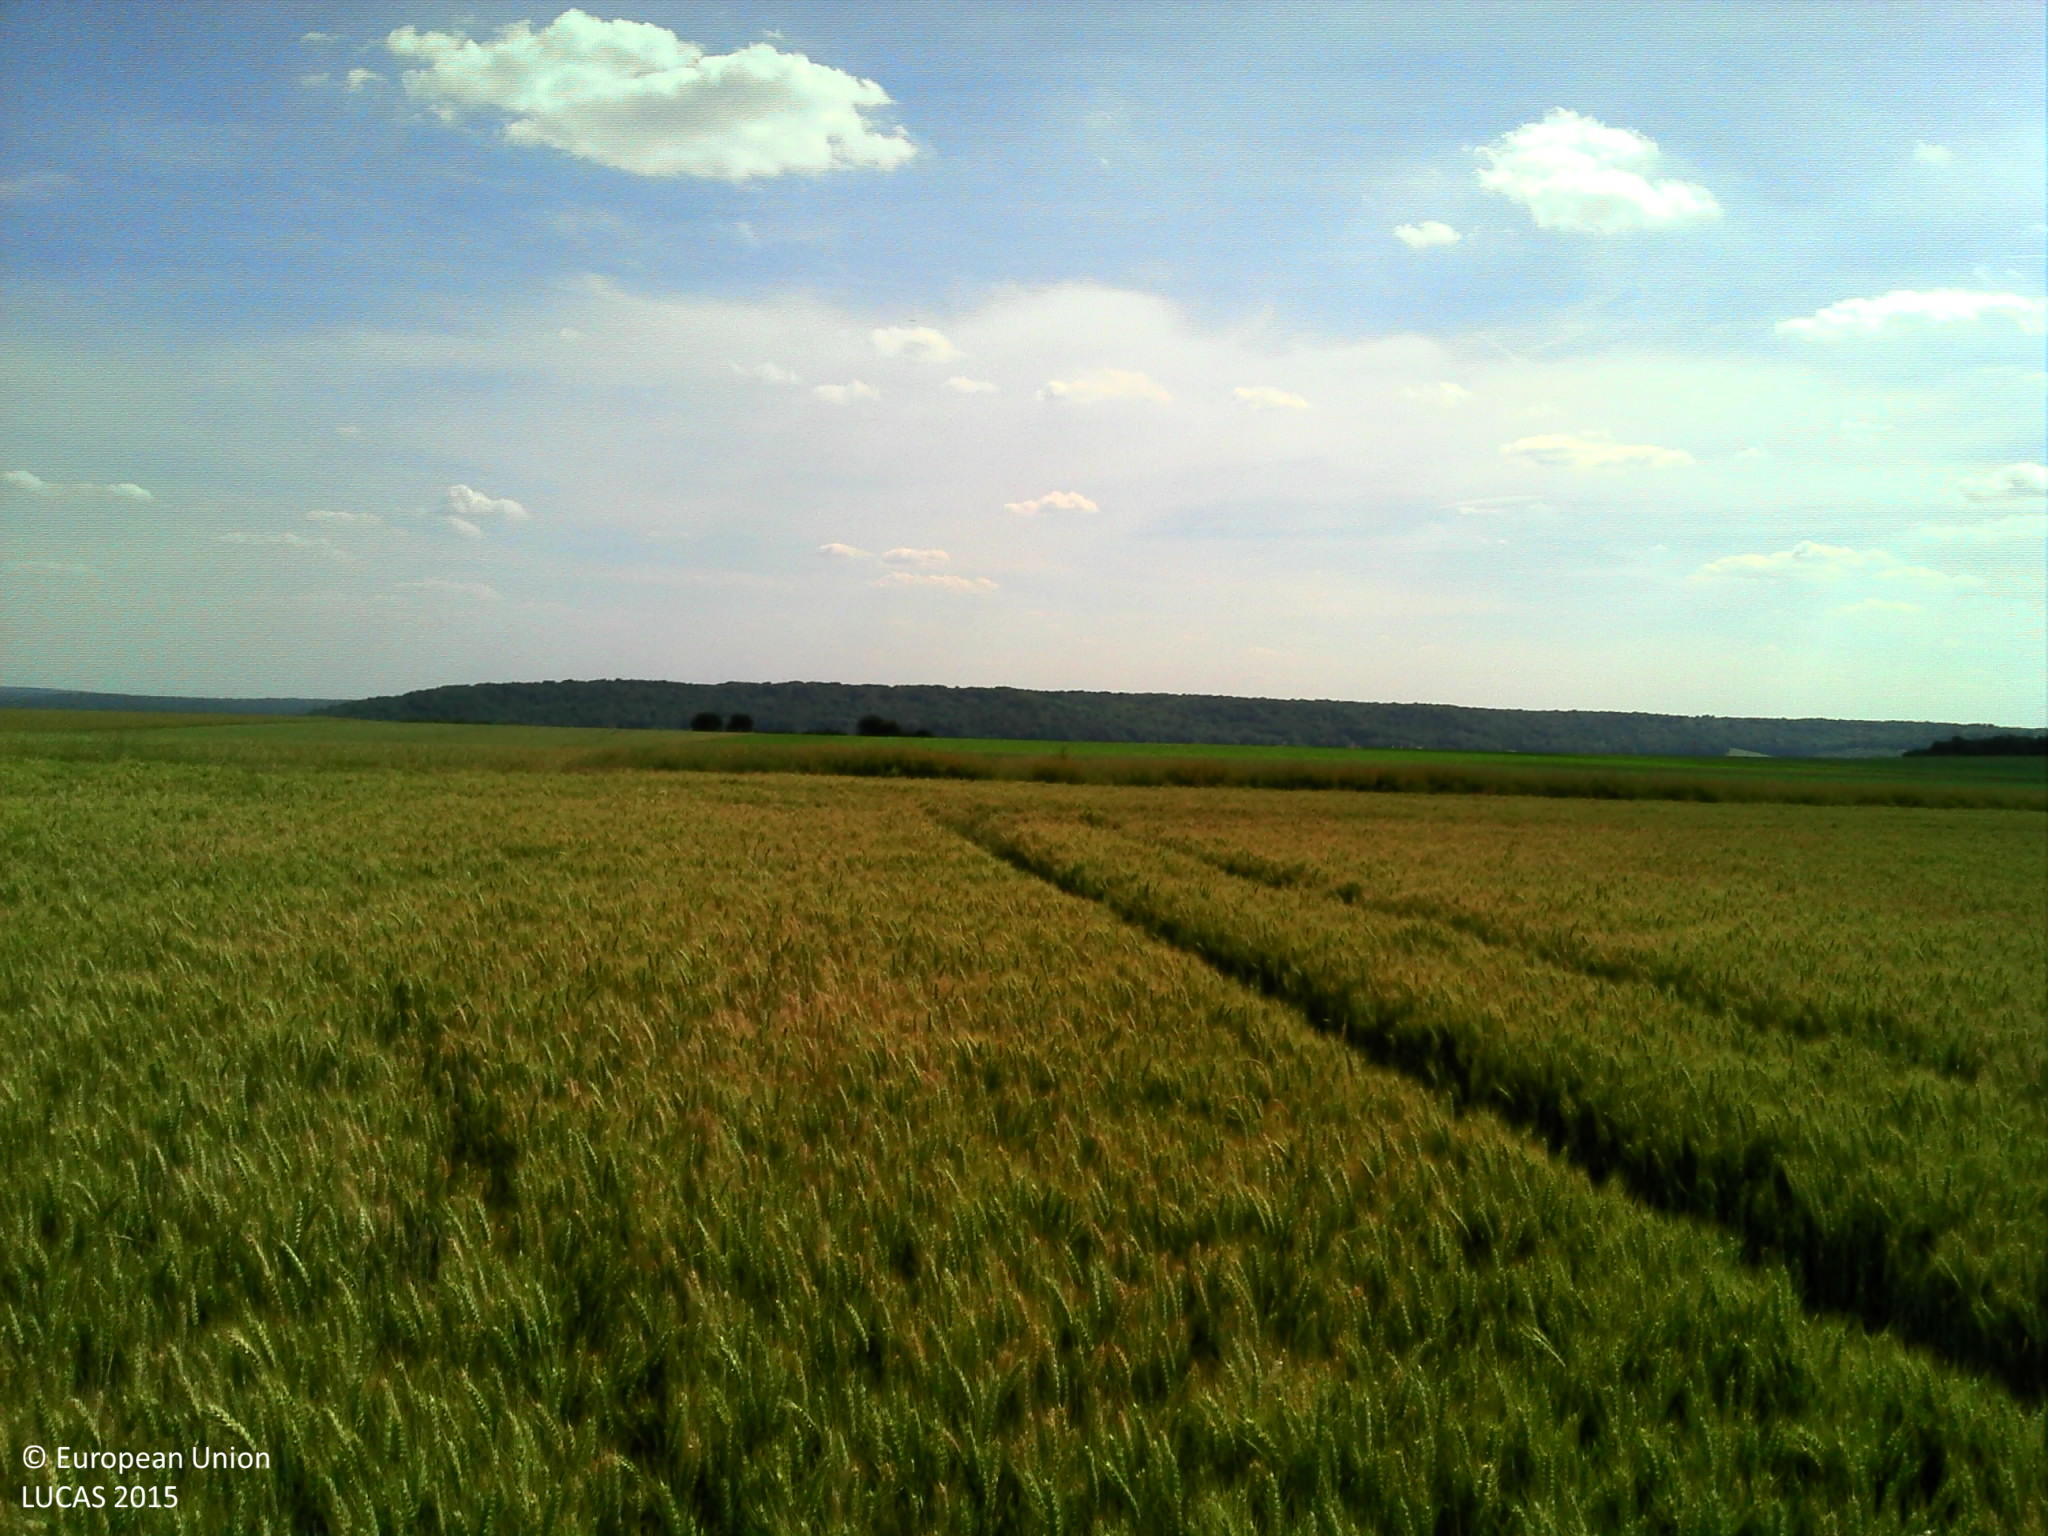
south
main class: Cropland
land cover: Common wheat
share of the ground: > 75 %
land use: Agriculture (excluding fallow land and kitchen gardens)
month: June
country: FR
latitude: 49.3974
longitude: 2.5338
